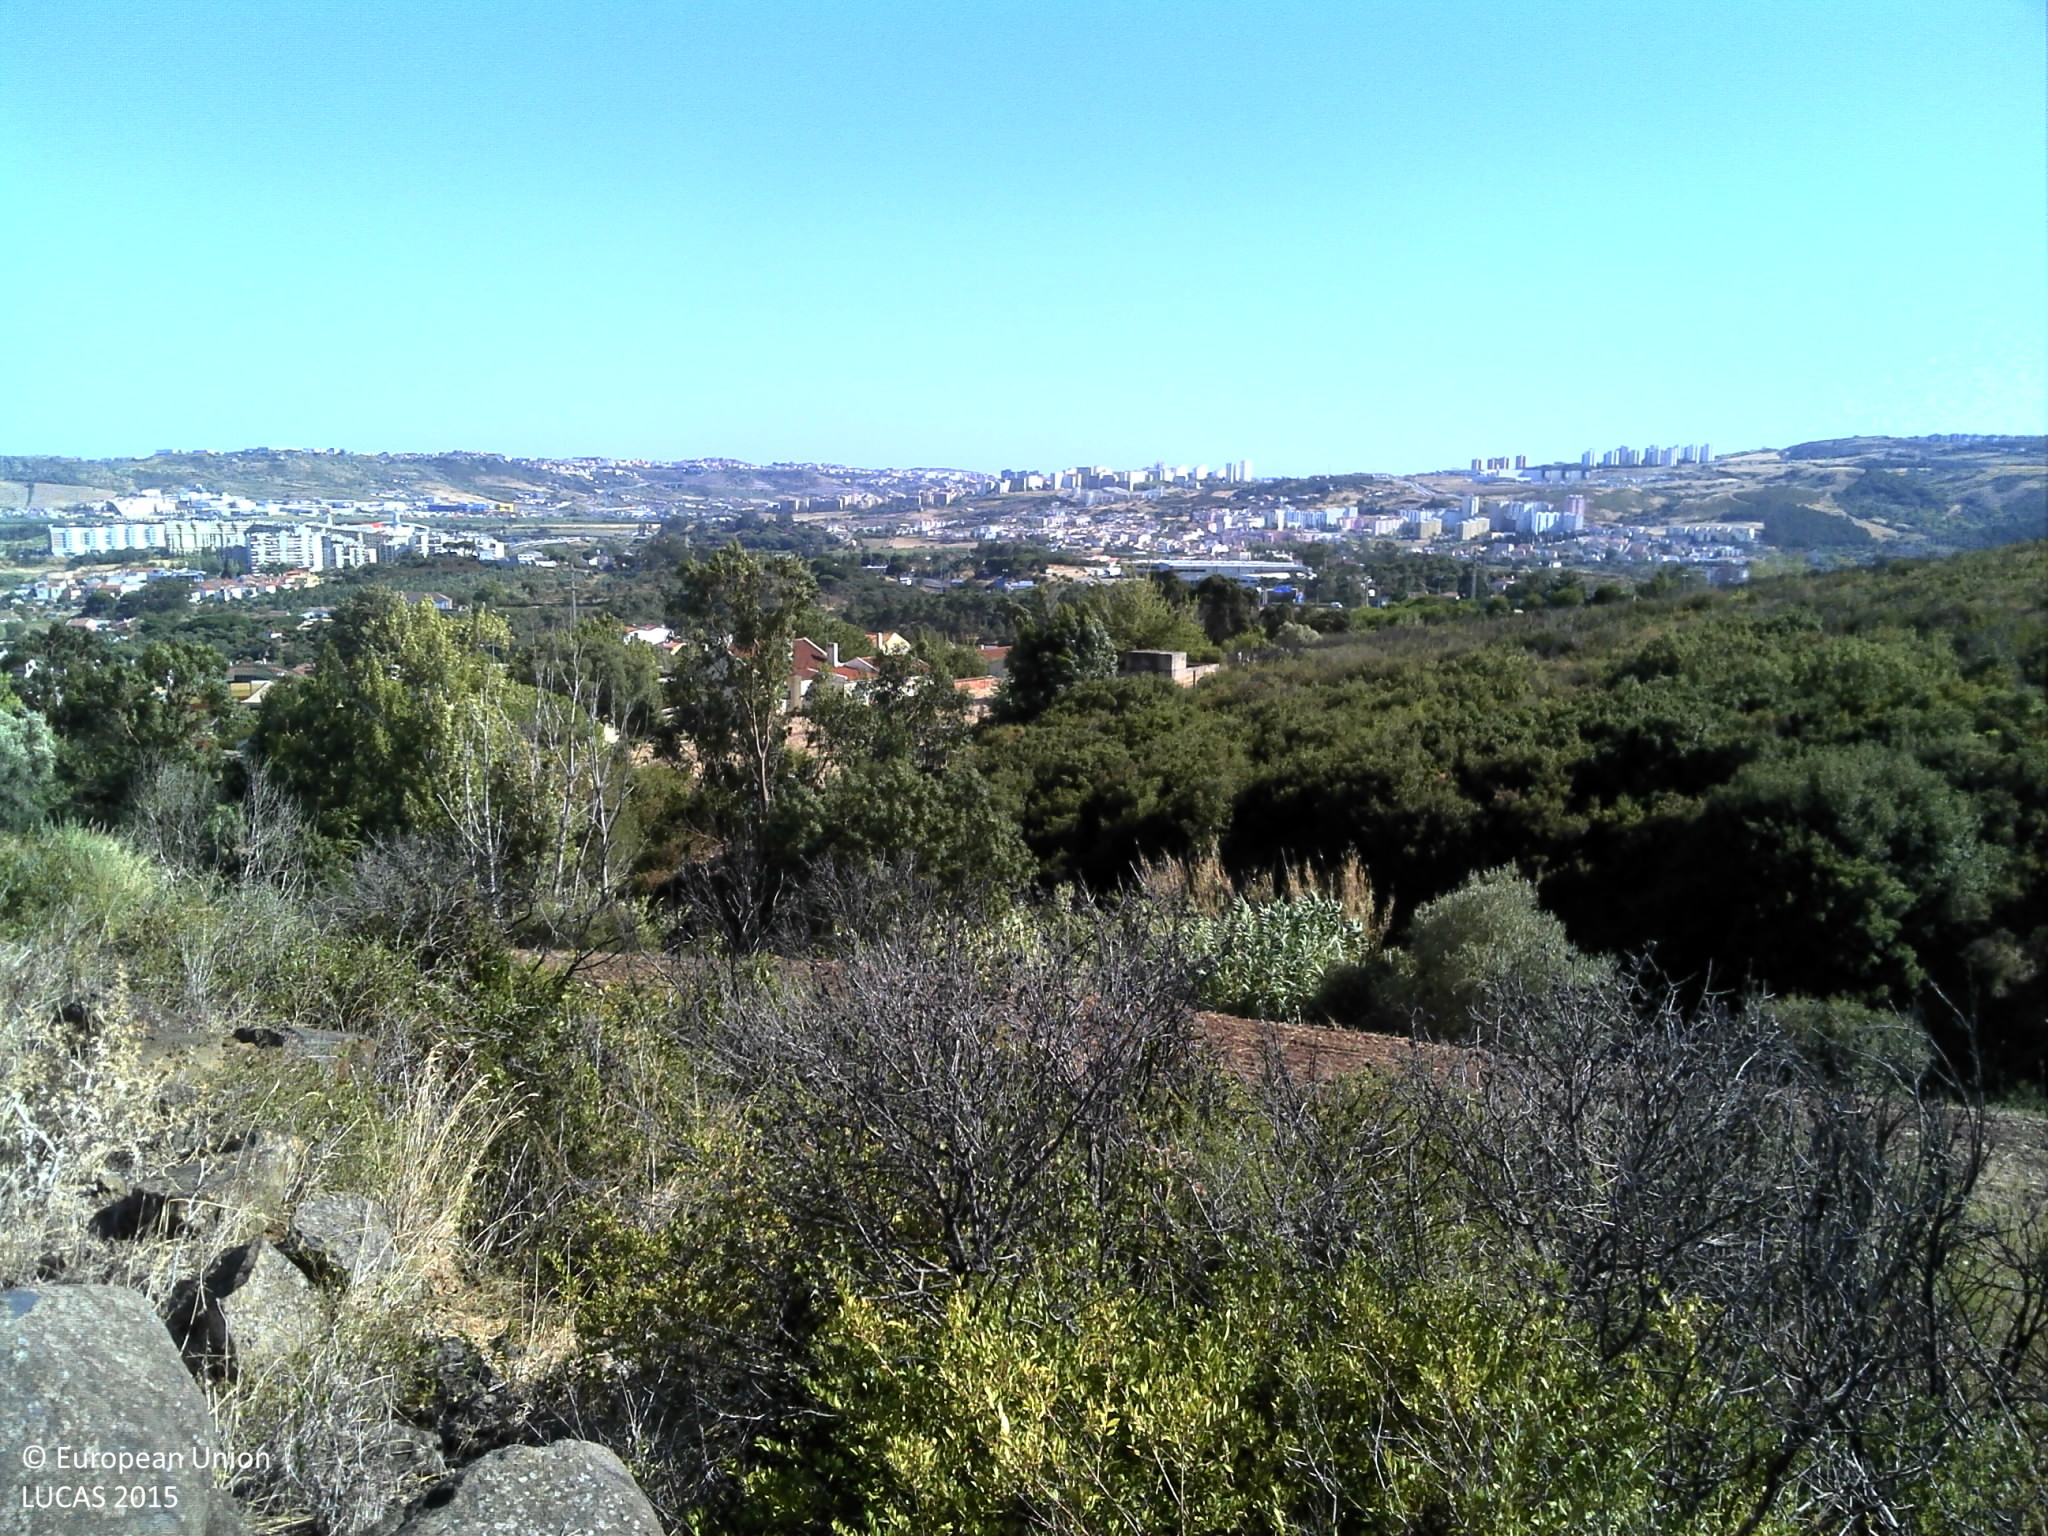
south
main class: Shrubland
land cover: Shrubland with sparse tree cover
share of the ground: 50 - 75 %
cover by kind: shrubs 65 %, unconsolidated bare surface 30 %, broadleaved forest trees 5 %
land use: Semi-natural and natural areas not in use
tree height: > 5 m
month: August
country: PT
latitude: 38.8566
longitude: -9.1733
